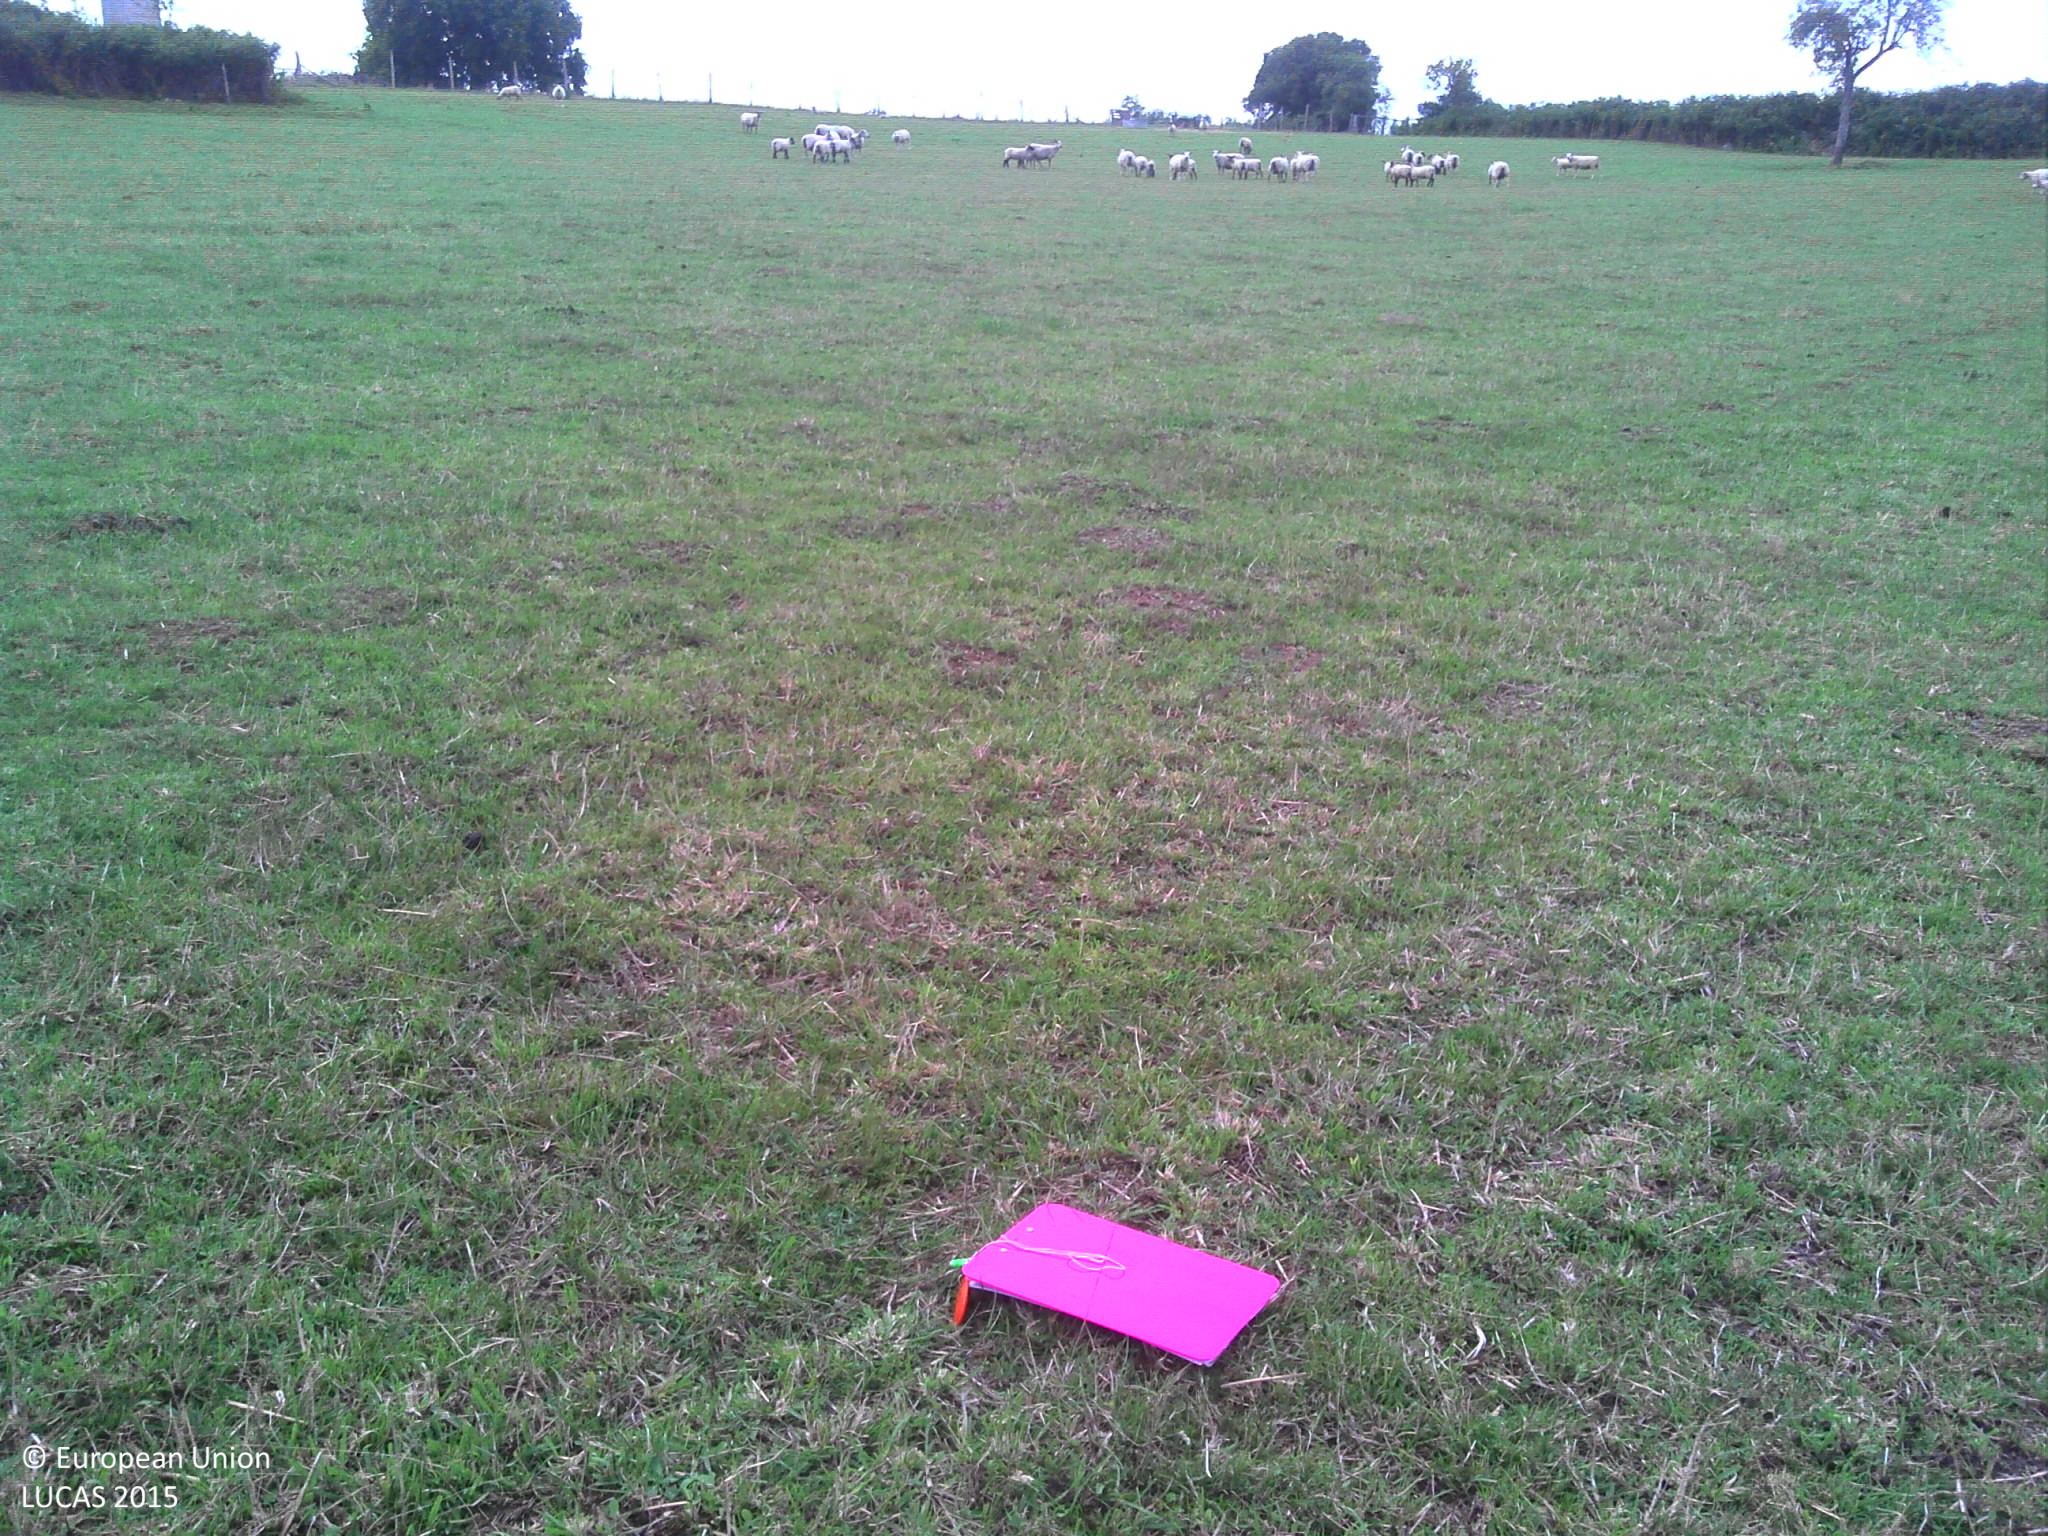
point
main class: Grassland
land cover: Grassland without tree/shrub cover
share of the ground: > 75 %
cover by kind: herbaceous plants 100 %
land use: Agriculture (excluding fallow land and kitchen gardens)
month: August
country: FR
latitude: 46.1172
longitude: 1.2292
